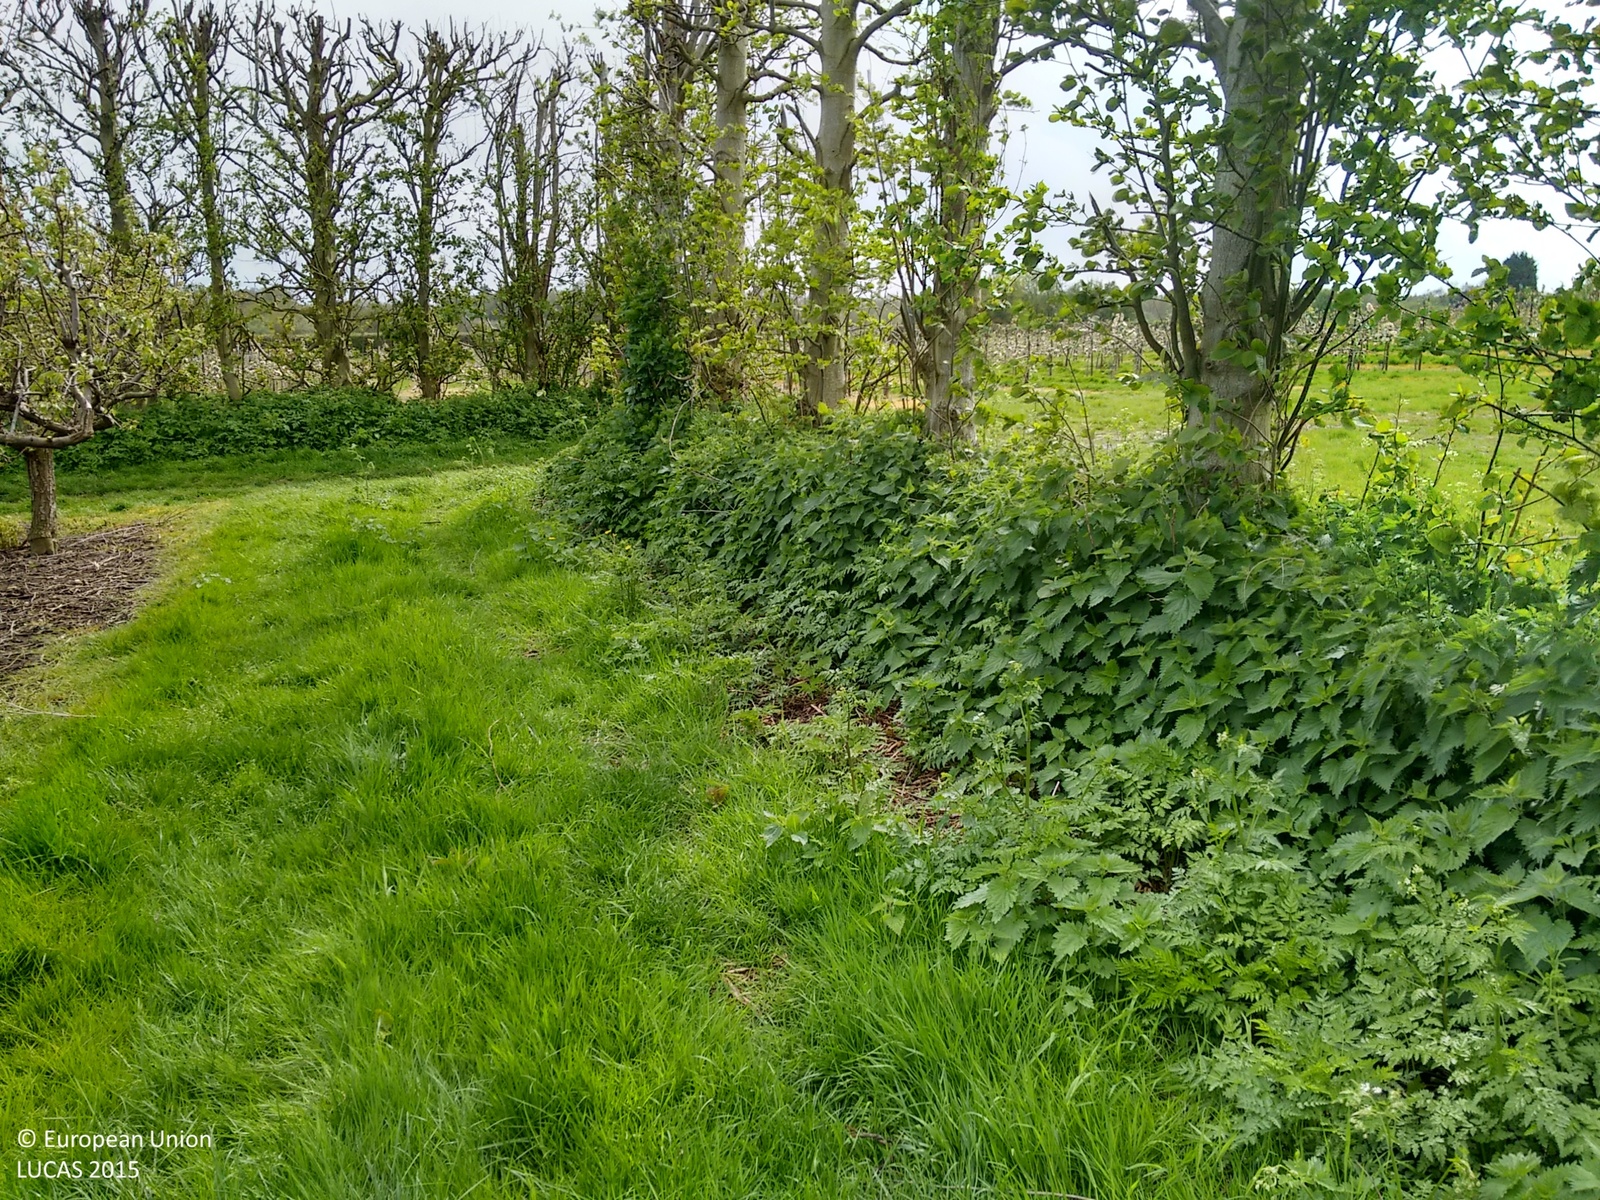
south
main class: Cropland
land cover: Pear fruit
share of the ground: 50 - 75 %
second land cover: Grassland without tree/shrub cover
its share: 50 - 75 %
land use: Agriculture (excluding fallow land and kitchen gardens)
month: May
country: GB
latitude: 51.2726
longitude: 0.2946
